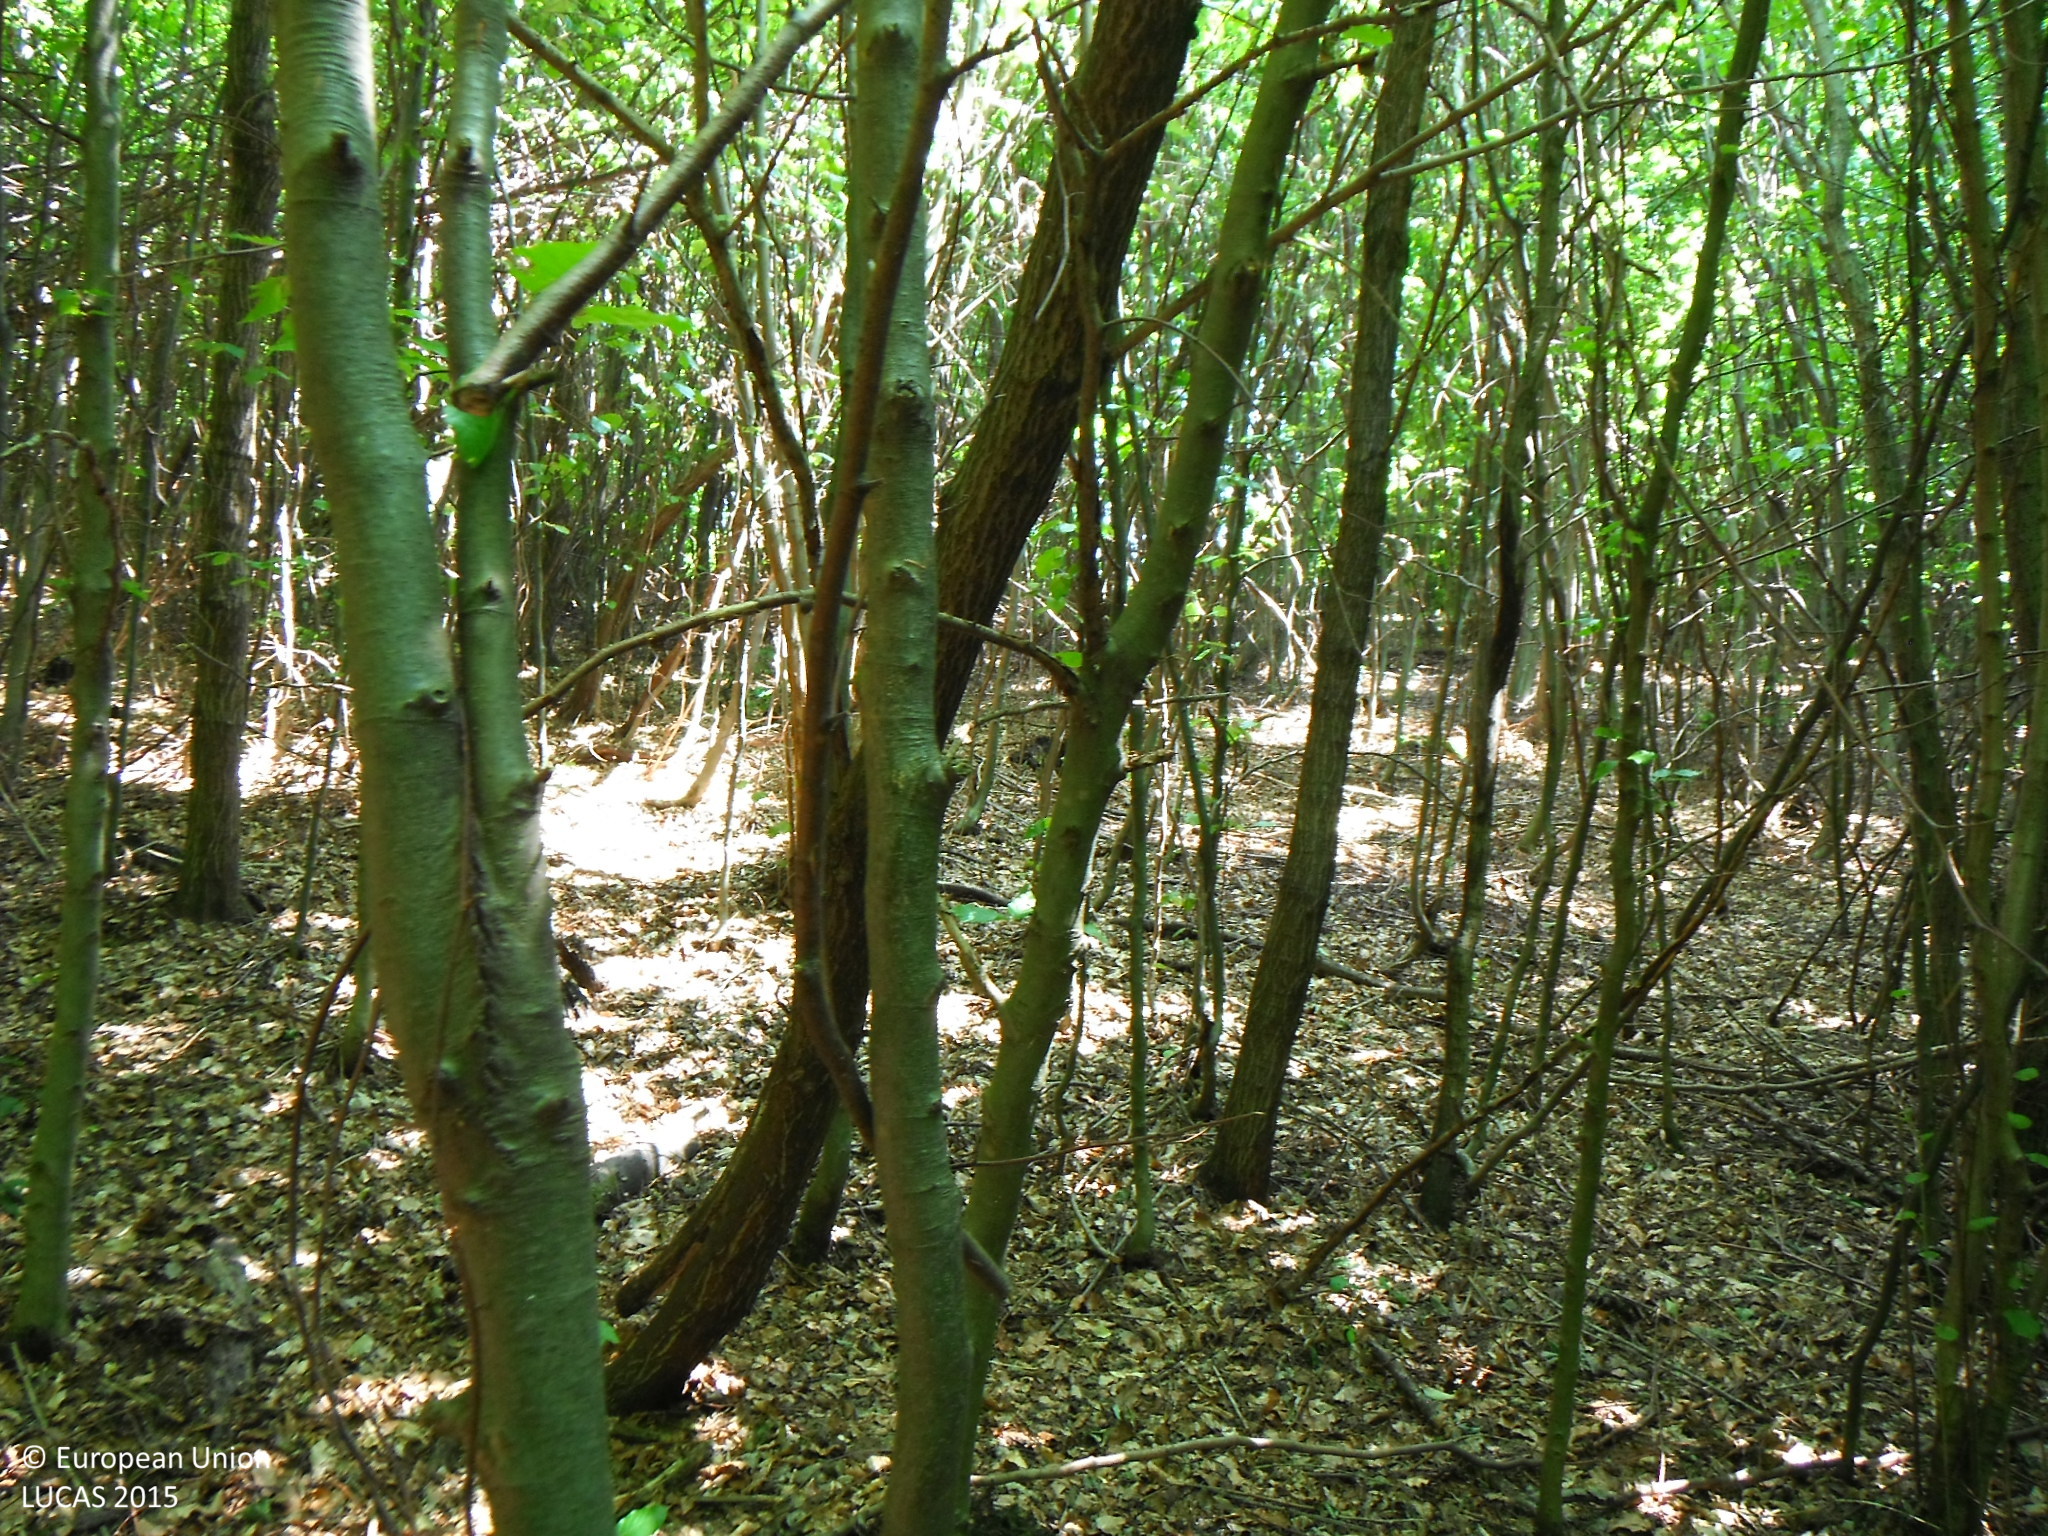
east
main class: Woodland
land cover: Broadleaved woodland
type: beech forest
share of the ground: > 75 %
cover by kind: broadleaved forest trees 100 %
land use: Forestry
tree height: > 5 m
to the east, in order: Broadleaved woodland; Grassland without tree/shrub cover; Broadleaved woodland; Tracks; Broadleaved woodland
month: July
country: SK
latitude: 49.3526
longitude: 21.4332
